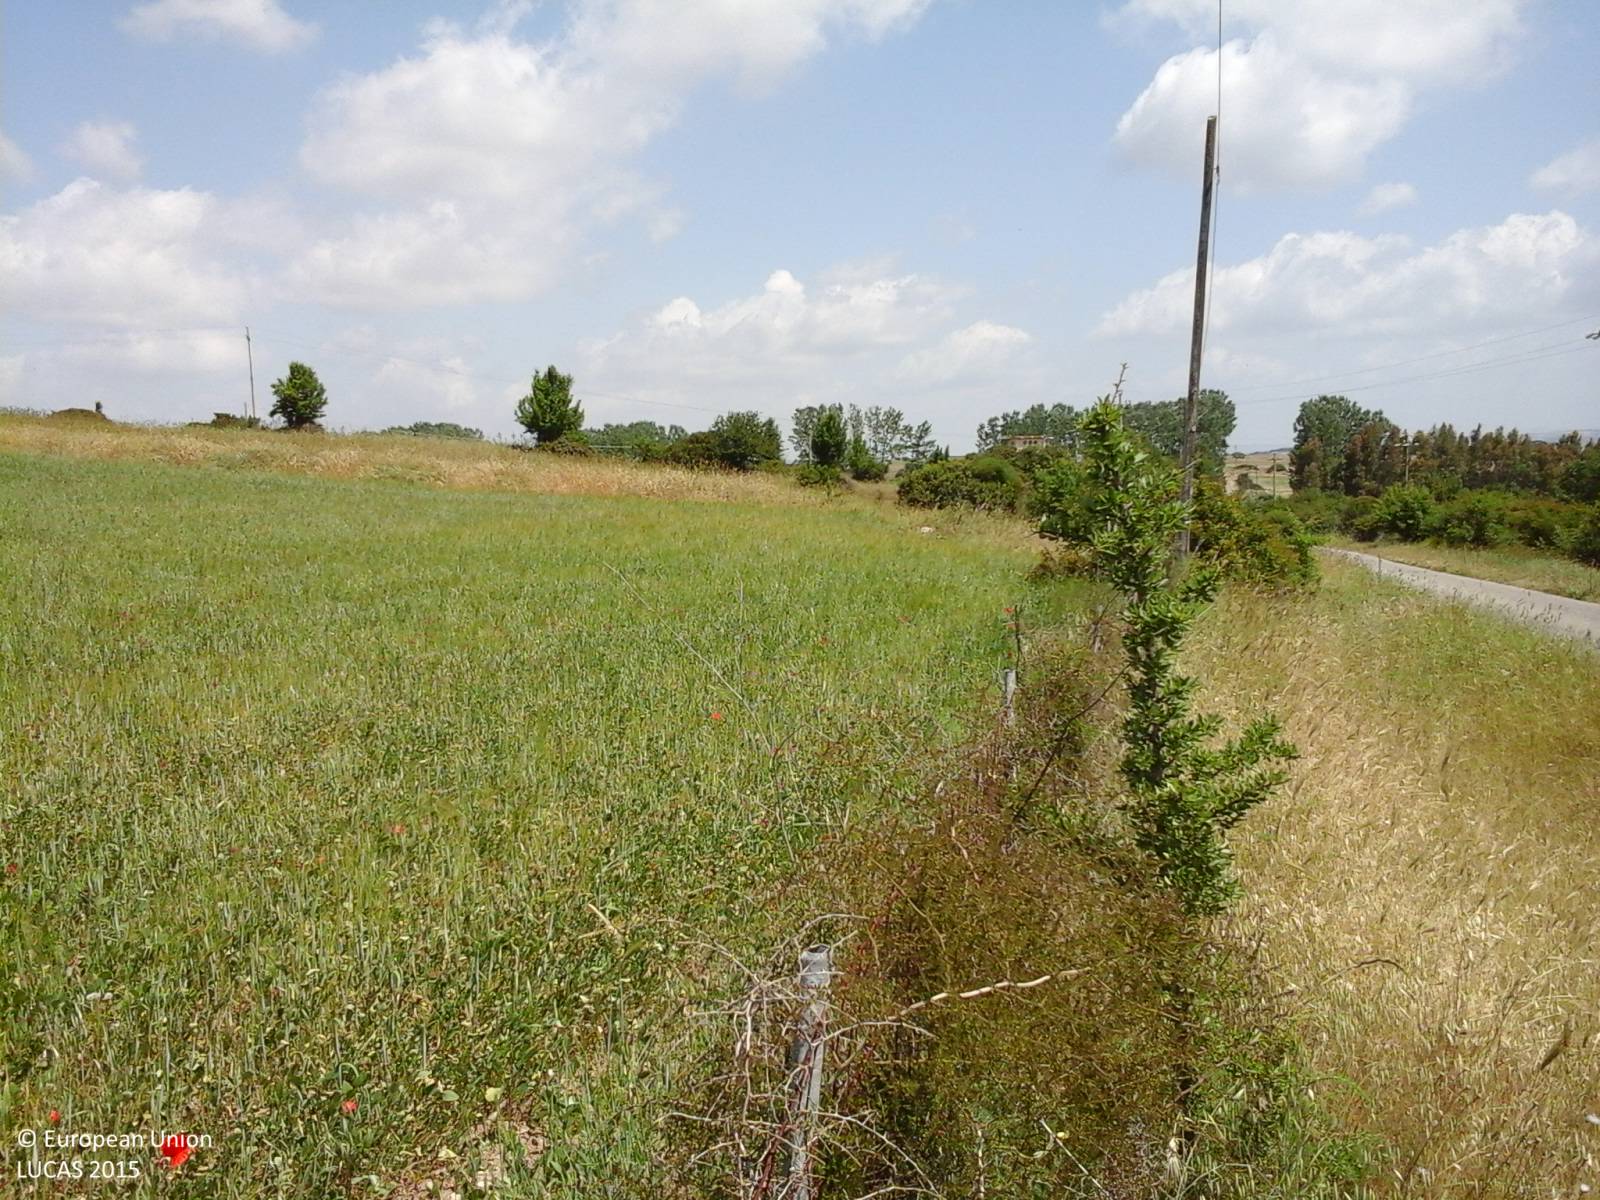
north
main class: Cropland
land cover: Other leguminous and mixtures for fodder
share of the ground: > 75 %
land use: Agriculture (excluding fallow land and kitchen gardens)
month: May
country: IT
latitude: 39.8082
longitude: 8.8733
